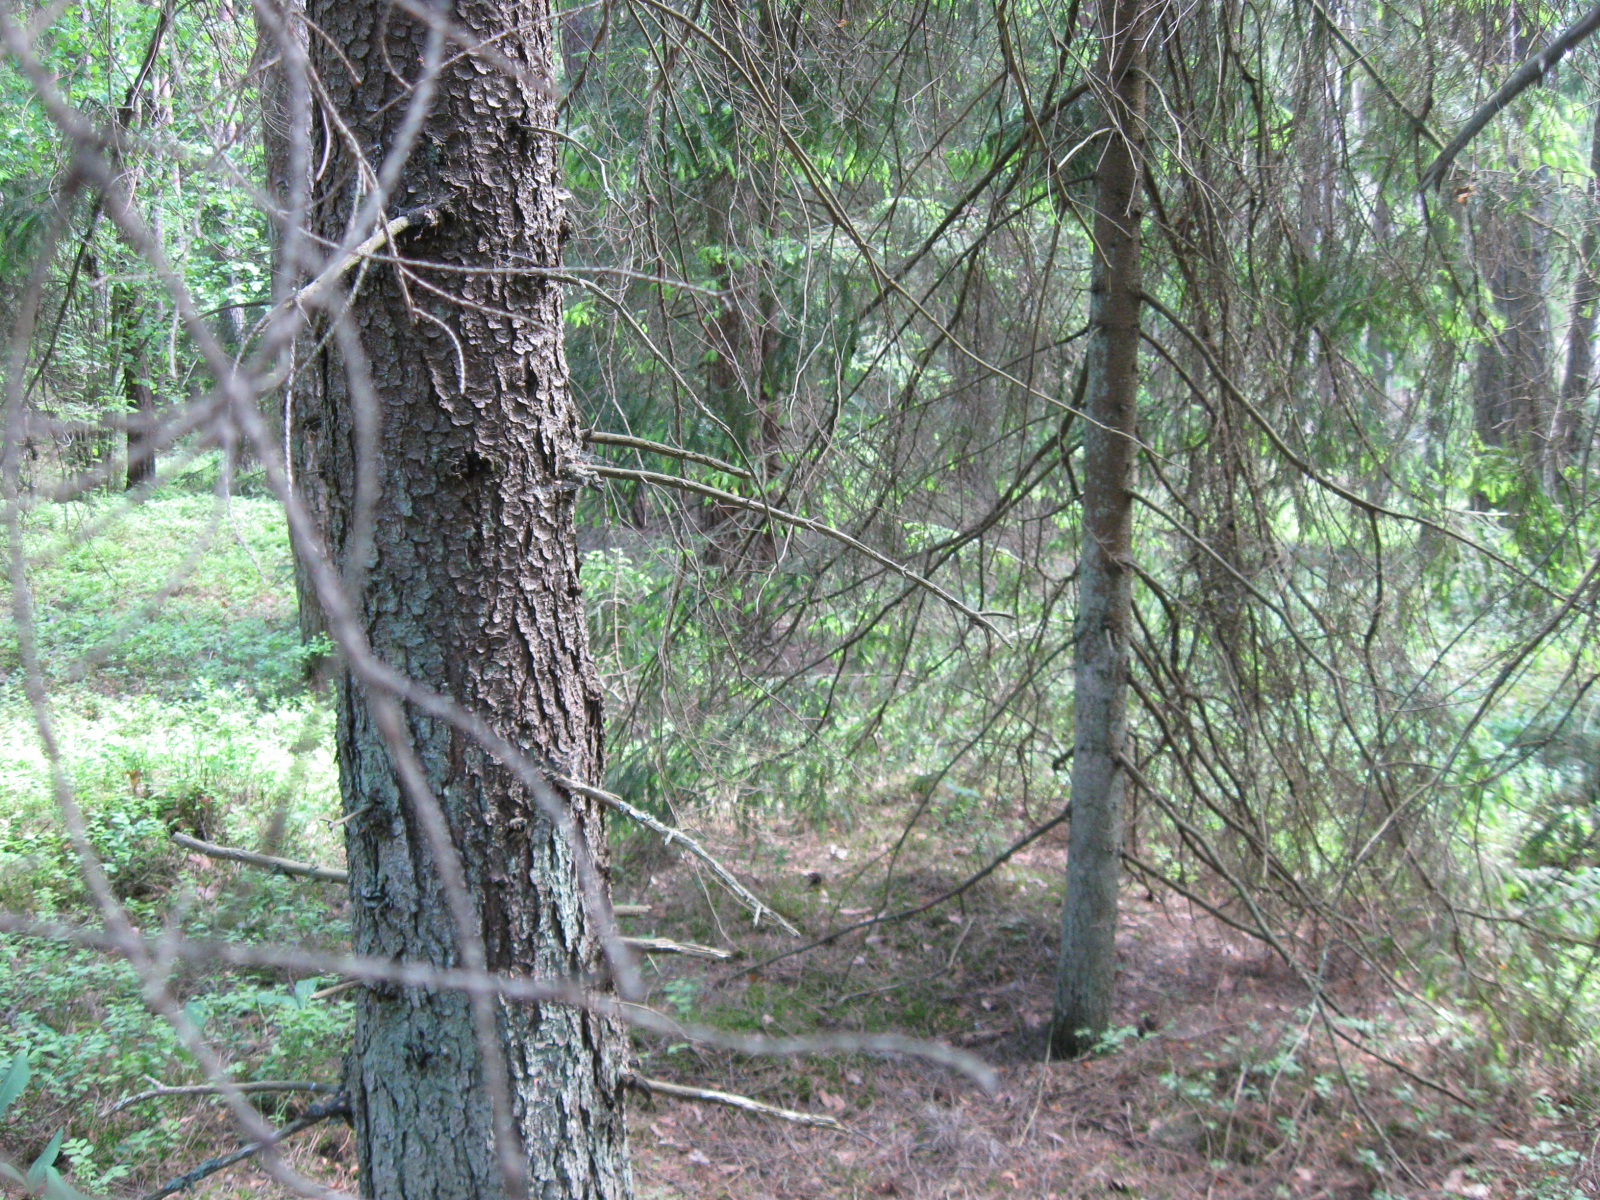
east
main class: Woodland
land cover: Other coniferous woodland
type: hemiboreal forest and nemoral coniferous forest and mixed broadleaved-coniferous forest
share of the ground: > 75 %
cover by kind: coniferous forest trees 90 %, herbaceous plants 10 %
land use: Forestry
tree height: > 5 m
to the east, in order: Other coniferous woodland; Paved roads, cycling and walking lanes; Pine dominated mixed woodland; Tracks; Pine dominated mixed woodland
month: June
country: LT
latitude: 54.6161
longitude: 23.7920
